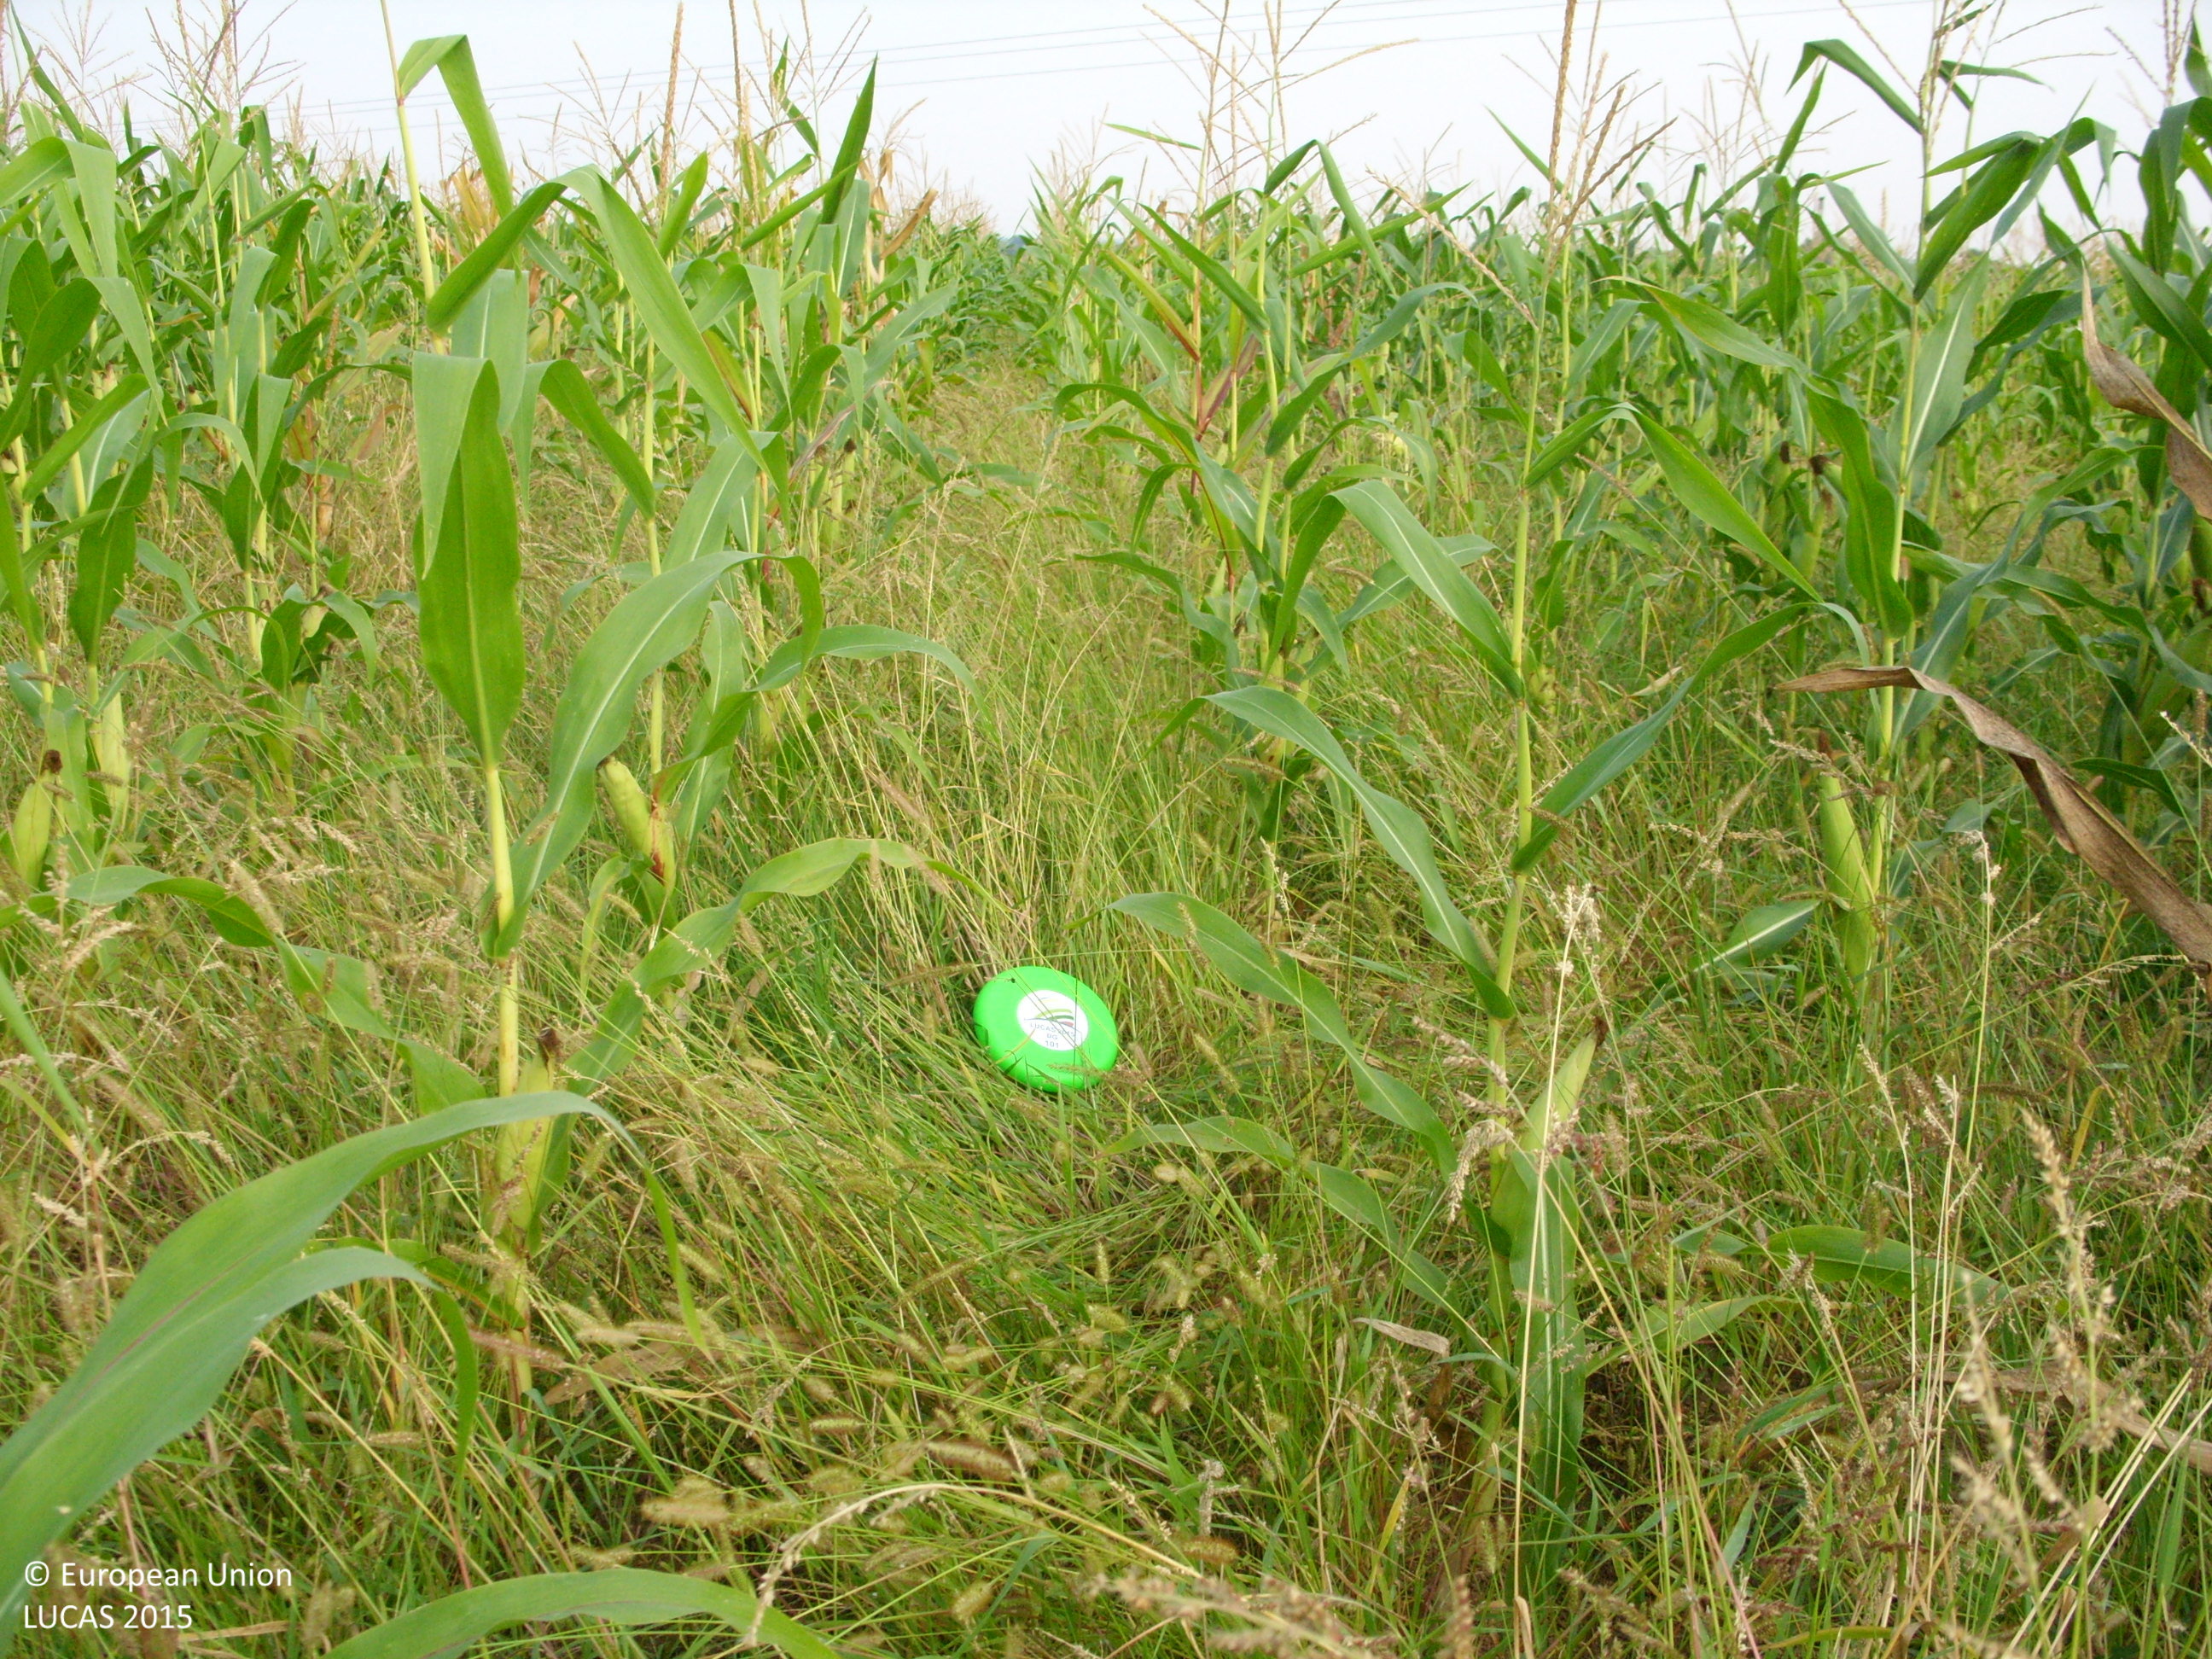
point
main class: Cropland
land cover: Maize
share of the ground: 50 - 75 %
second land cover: Spontaneously vegetated surfaces
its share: > 75 %
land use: Agriculture (excluding fallow land and kitchen gardens)
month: September
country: BG
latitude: 42.4252
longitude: 24.7737
